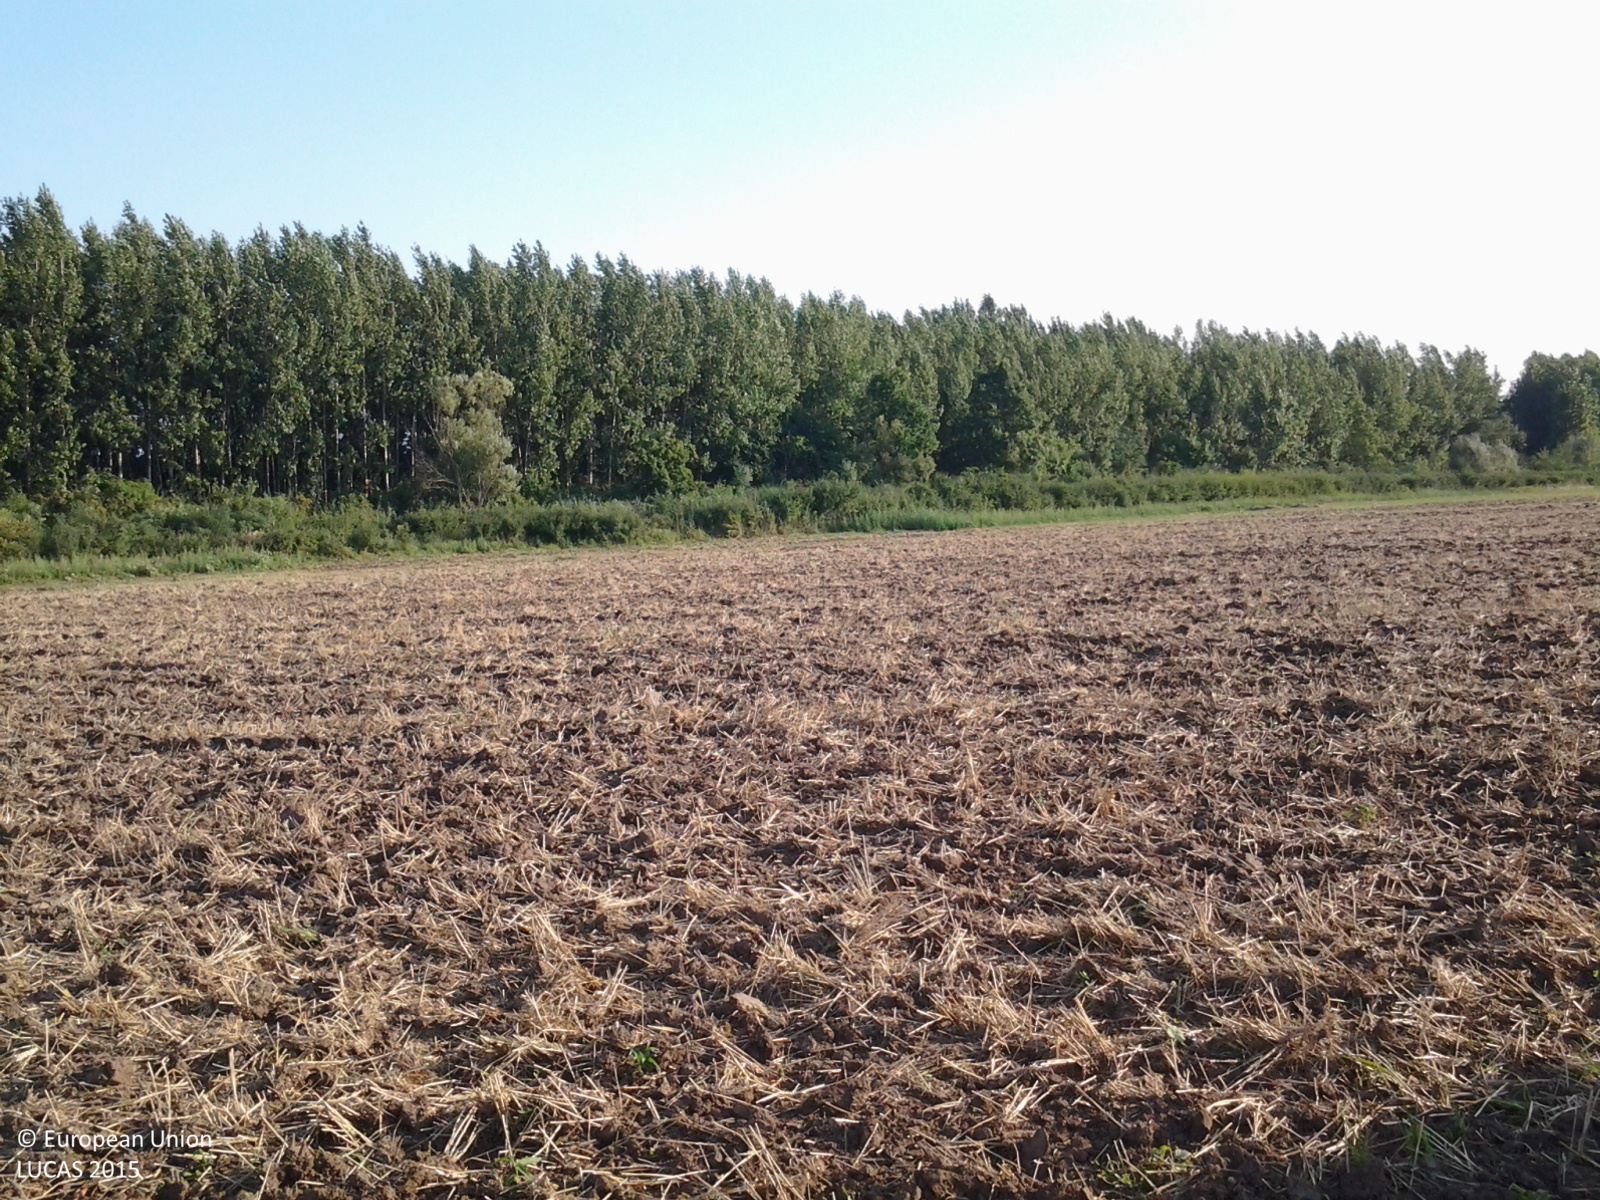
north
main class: Cropland
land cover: Common wheat
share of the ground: < 10 %
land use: Agriculture (excluding fallow land and kitchen gardens)
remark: Harvested field
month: August
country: HU
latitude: 46.9020
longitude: 21.5797
